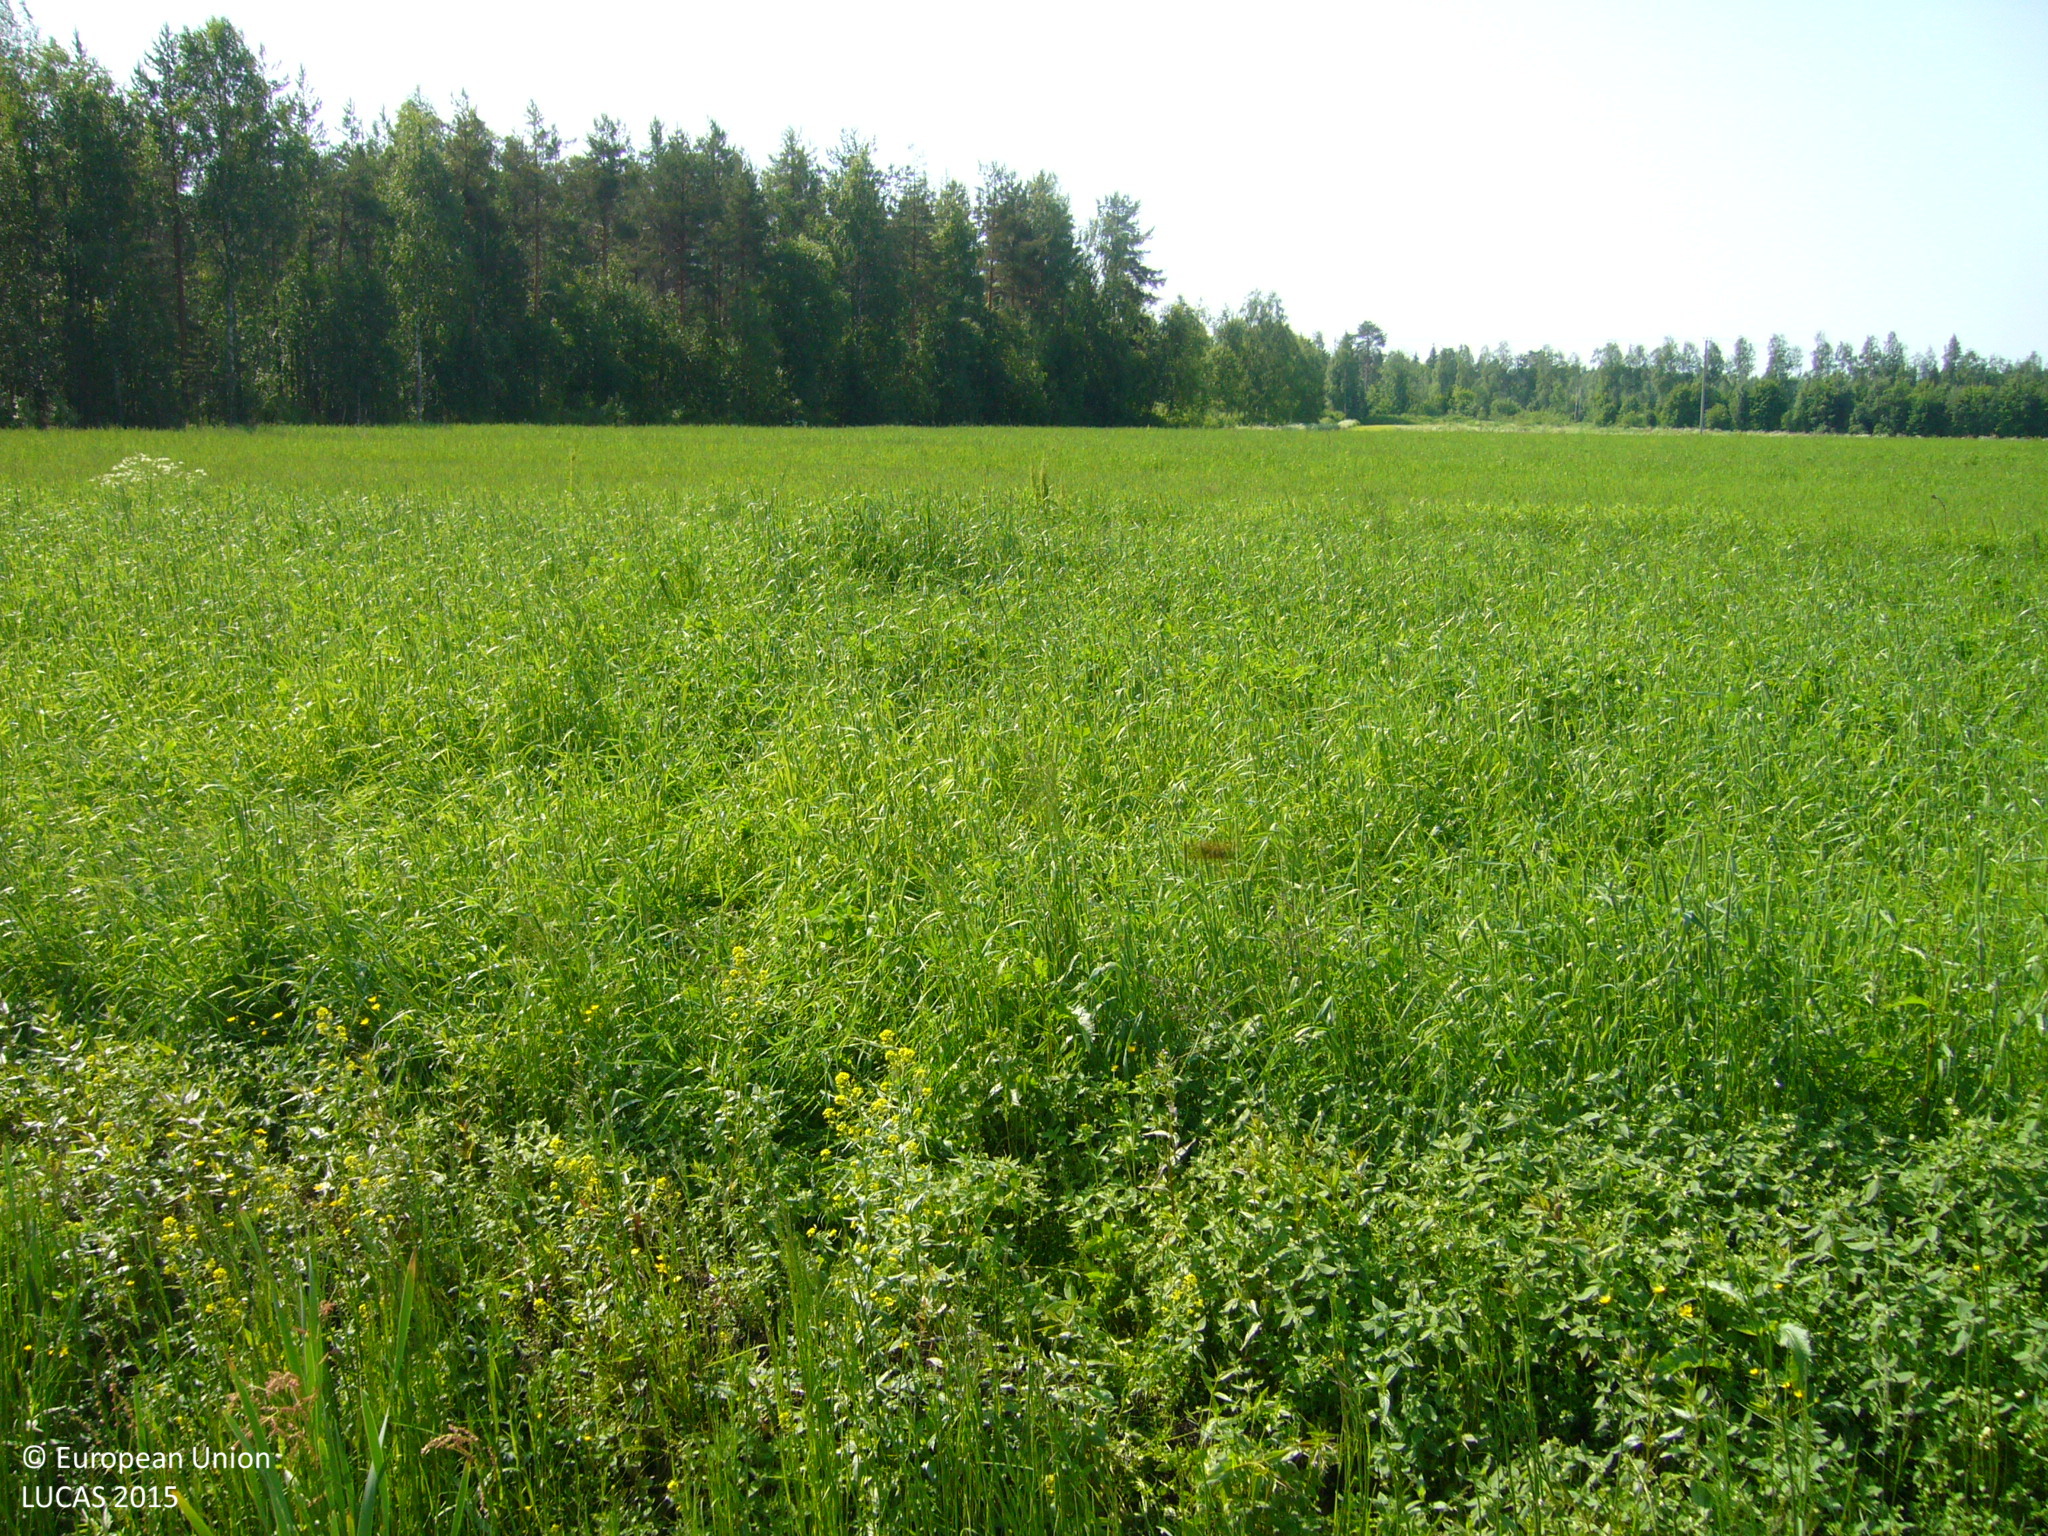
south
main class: Cropland
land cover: Temporary grasslands
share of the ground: > 75 %
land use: Agriculture (excluding fallow land and kitchen gardens)
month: July
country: FI
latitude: 63.6640
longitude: 25.8880
